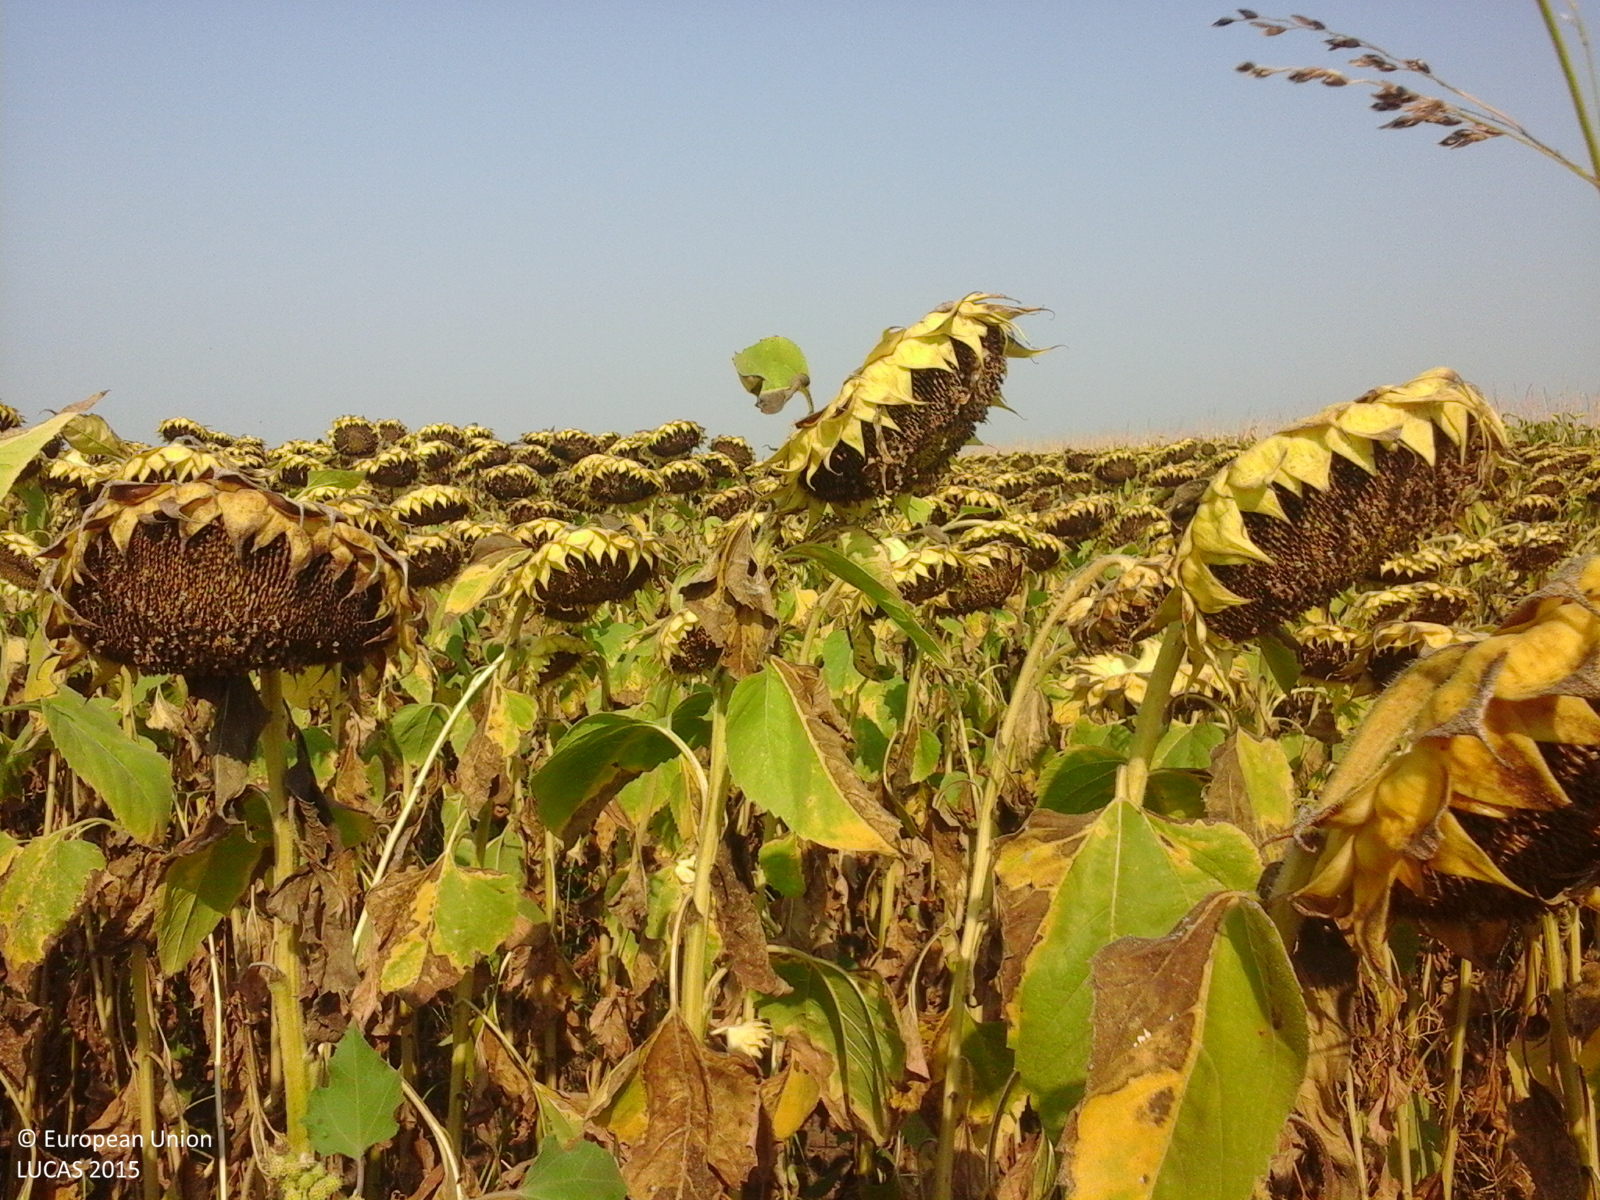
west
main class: Cropland
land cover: Sunflower
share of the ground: > 75 %
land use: Agriculture (excluding fallow land and kitchen gardens)
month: August
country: RO
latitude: 43.9333
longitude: 23.2616
